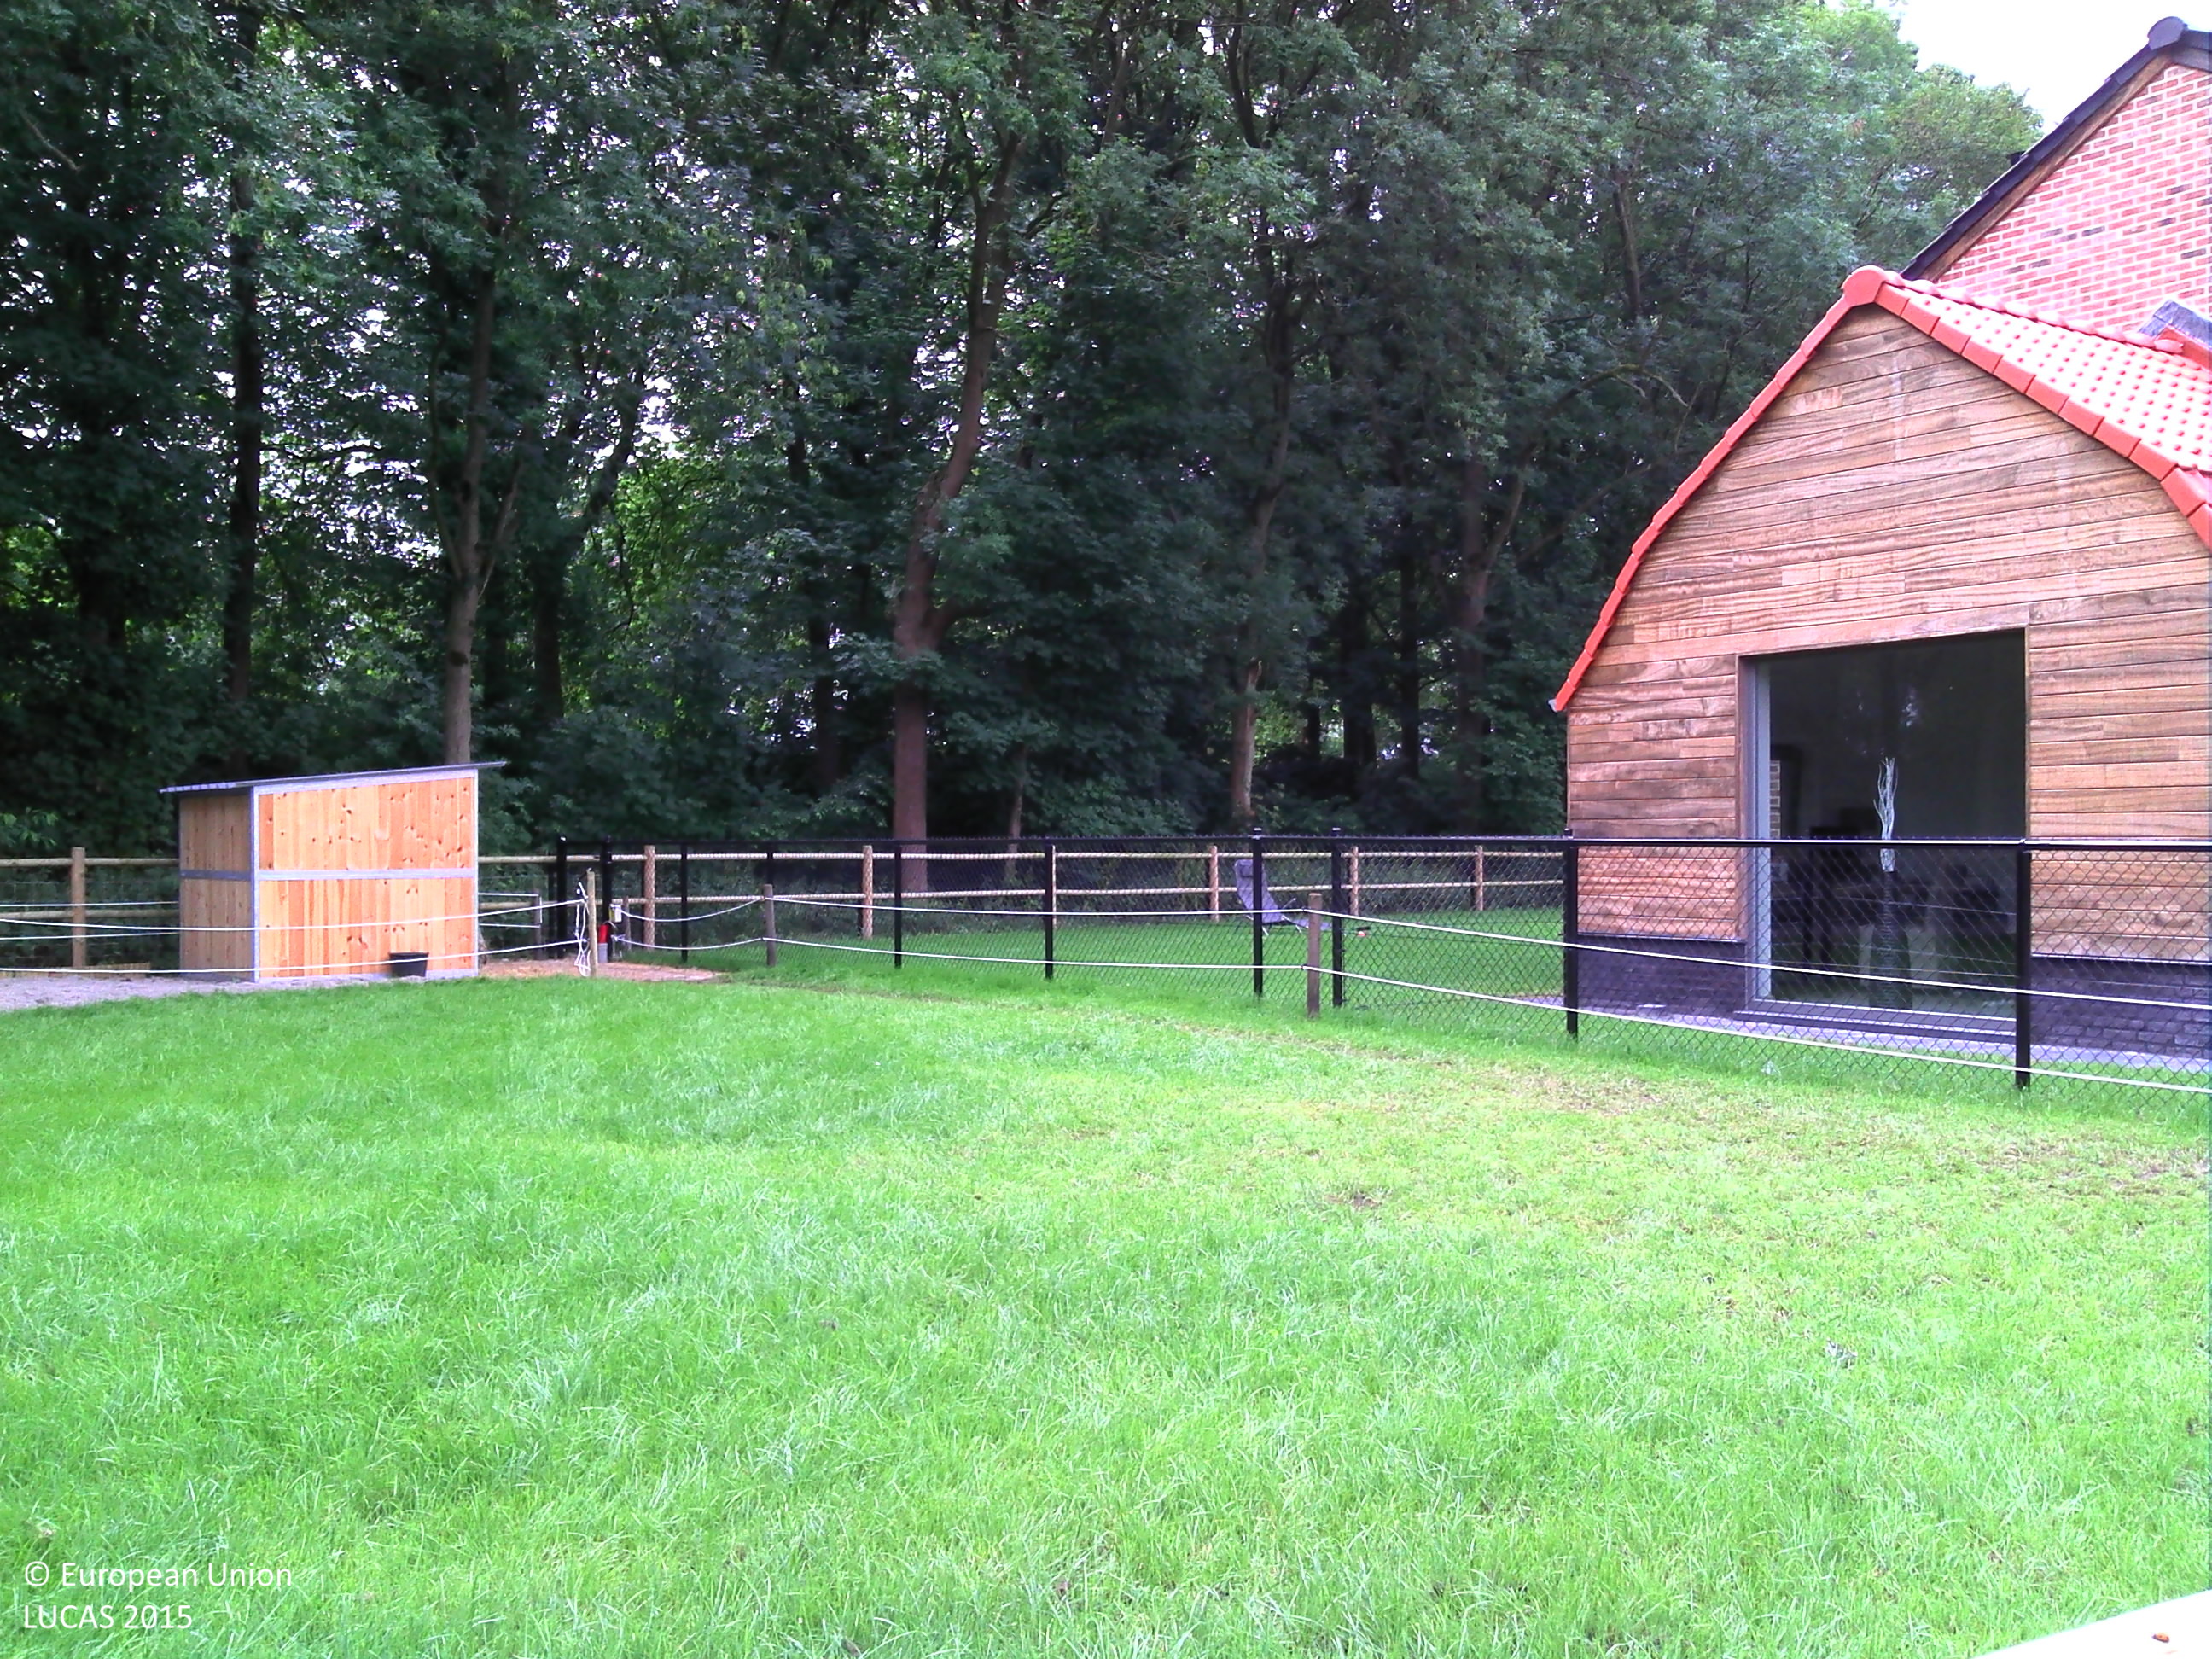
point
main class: Woodland
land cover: Broadleaved woodland
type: mesophytic deciduous forest
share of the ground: > 75 %
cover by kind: broadleaved forest trees 90 %, herbaceous plants 10 %
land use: Semi-natural and natural areas not in use
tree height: > 5 m
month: July
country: BE
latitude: 51.2295
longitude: 5.4871
